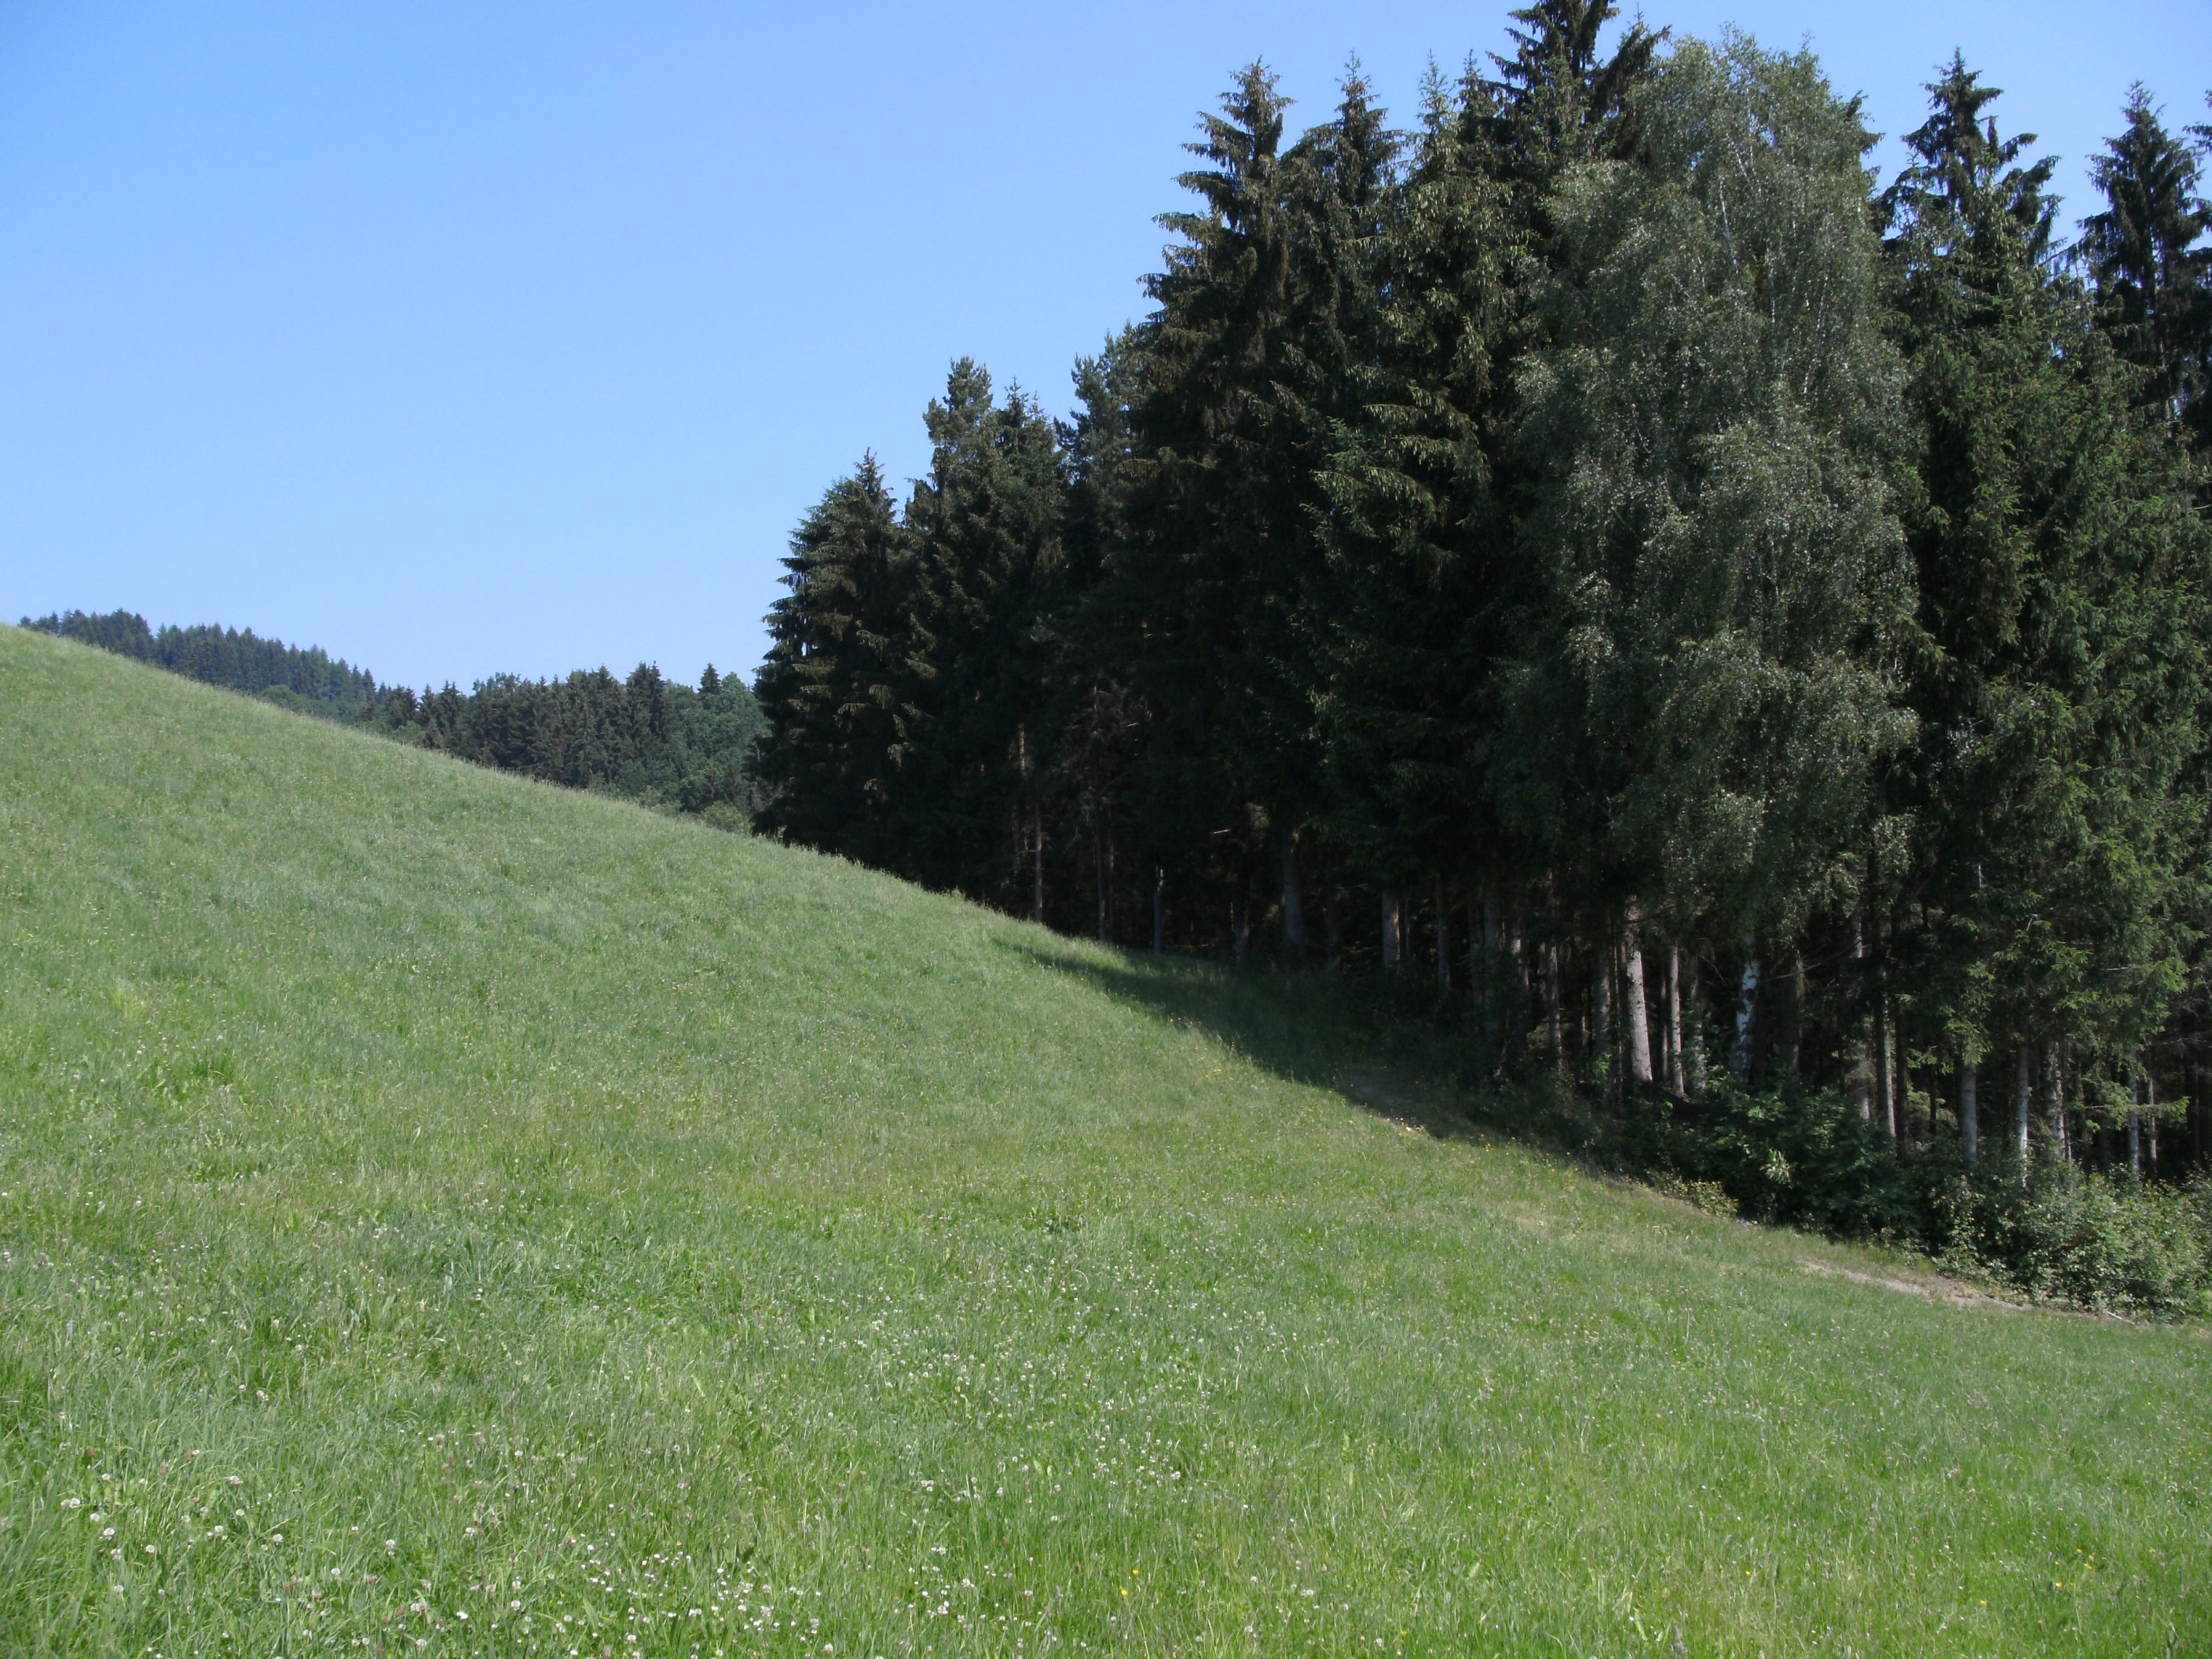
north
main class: Grassland
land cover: Grassland without tree/shrub cover
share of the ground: > 75 %
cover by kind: herbaceous plants 100 %
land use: Agriculture (excluding fallow land and kitchen gardens)
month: June
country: AT
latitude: 48.4138
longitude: 14.2020
